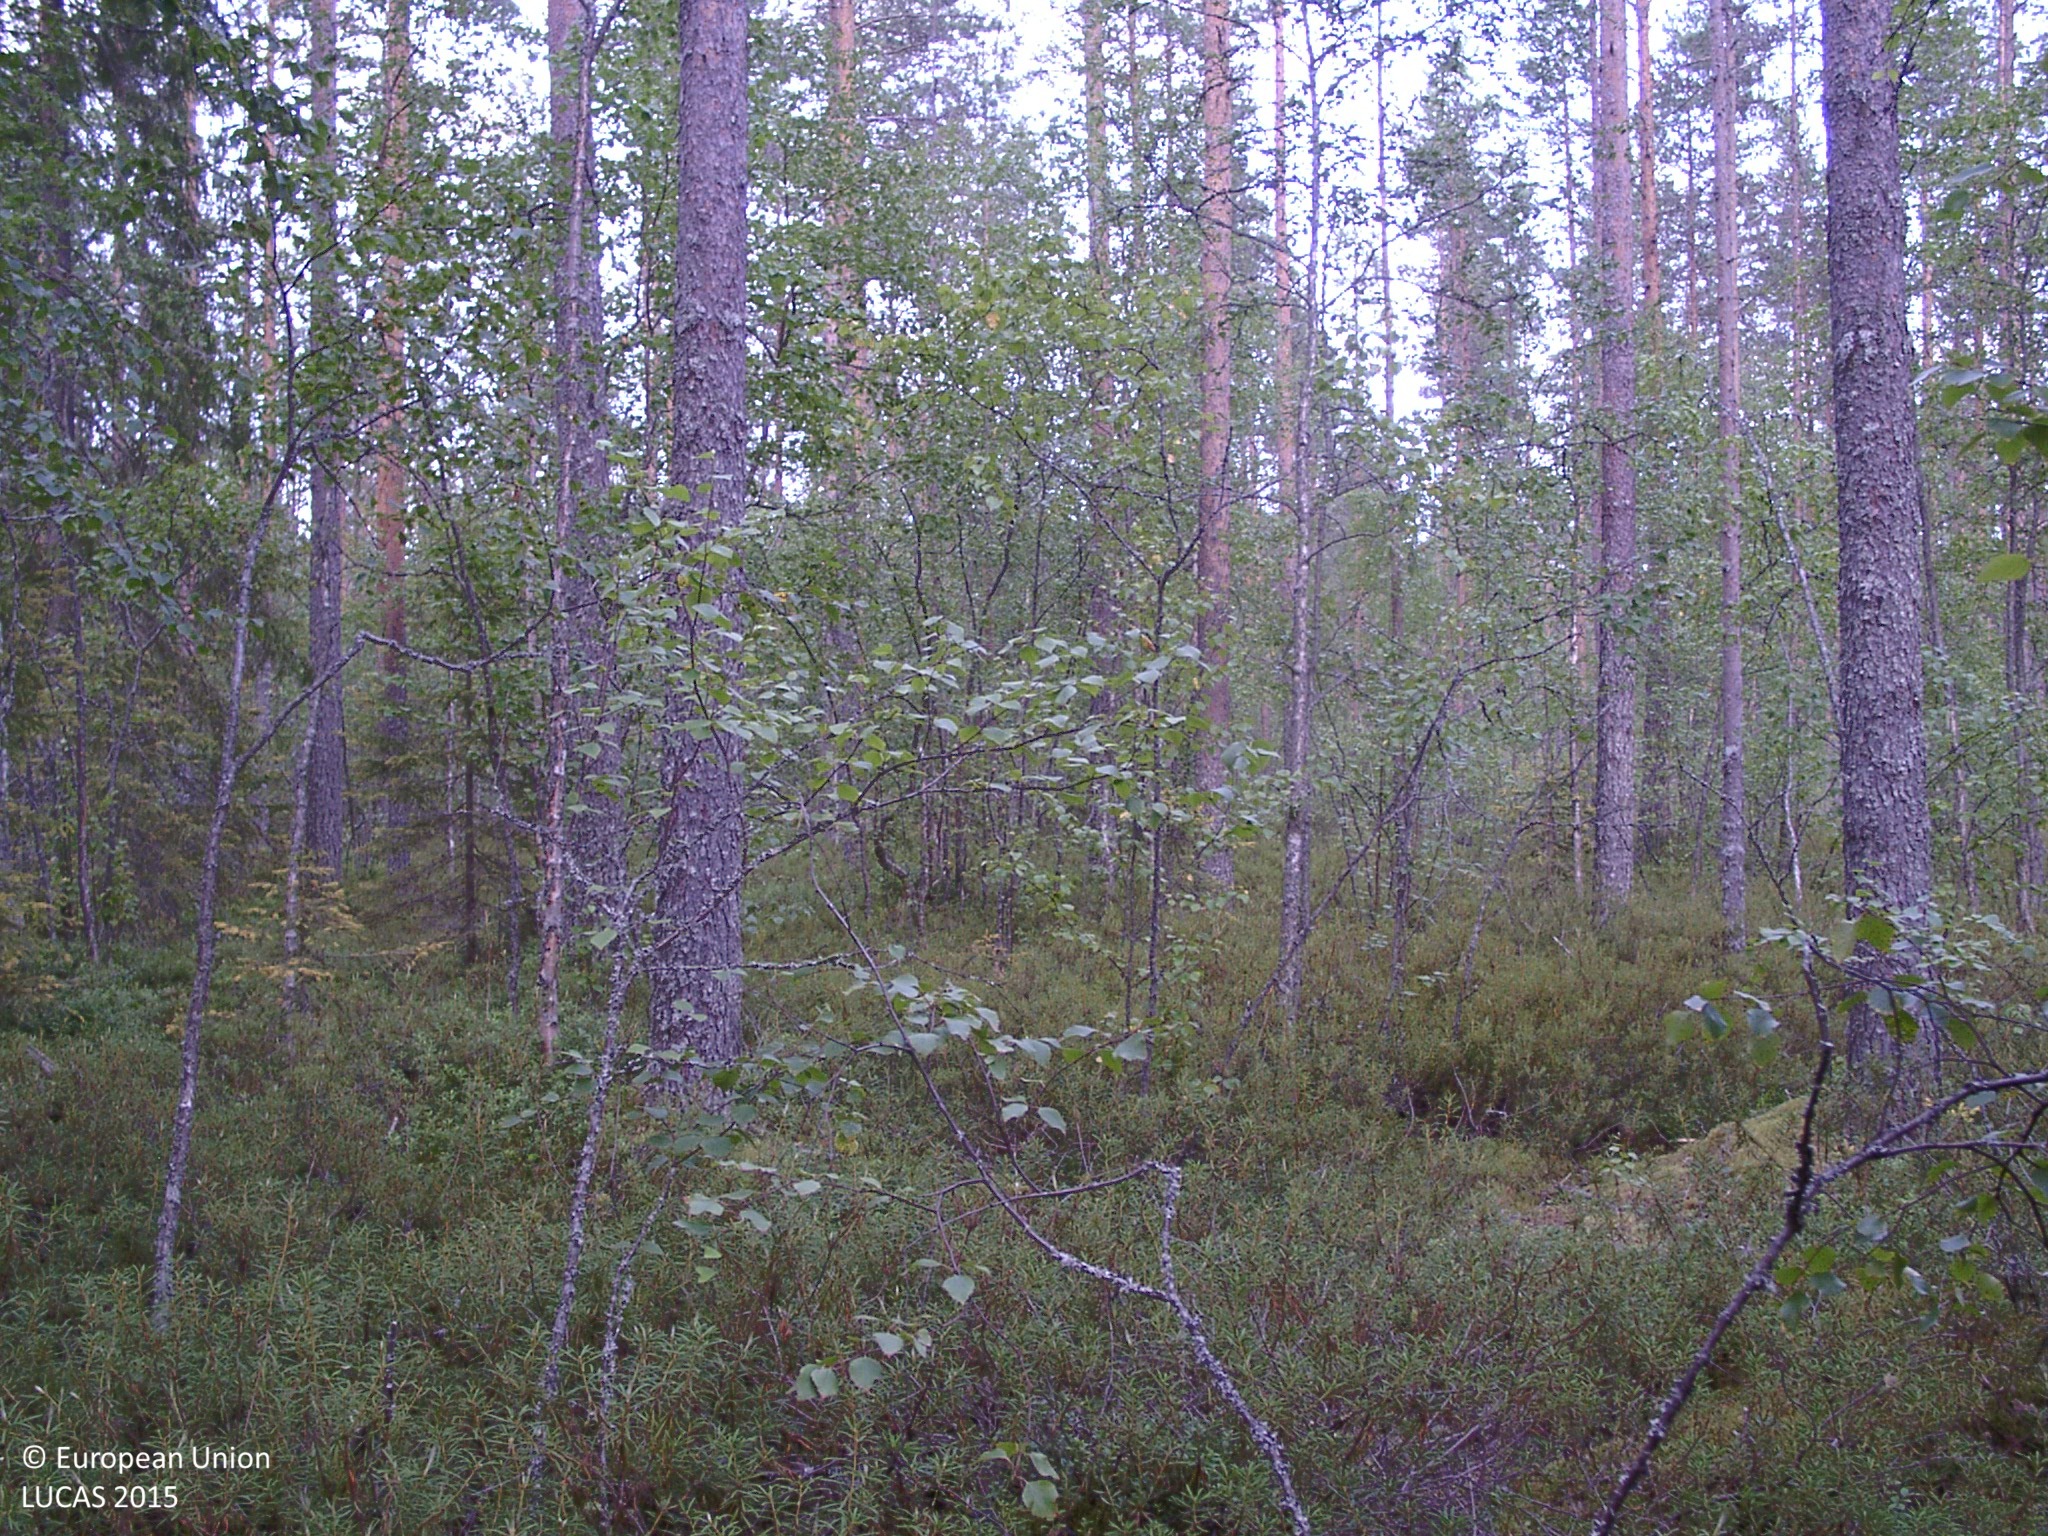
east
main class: Woodland
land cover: Pine dominated mixed woodland
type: mire and swamp forests
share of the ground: 50 - 75 %
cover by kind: coniferous forest trees 45 %, shrubs 30 %, broadleaved forest trees 20 %, lichens and mosses 5 %
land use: Forestry
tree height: > 5 m
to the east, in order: Pine dominated mixed woodland; Ditches and canals; Pine dominated mixed woodland; Shruby margins; Other mixed woodland; Grass margins; Other mixed woodland; Ditches and canals
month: August
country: FI
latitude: 62.9080
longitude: 24.5932
